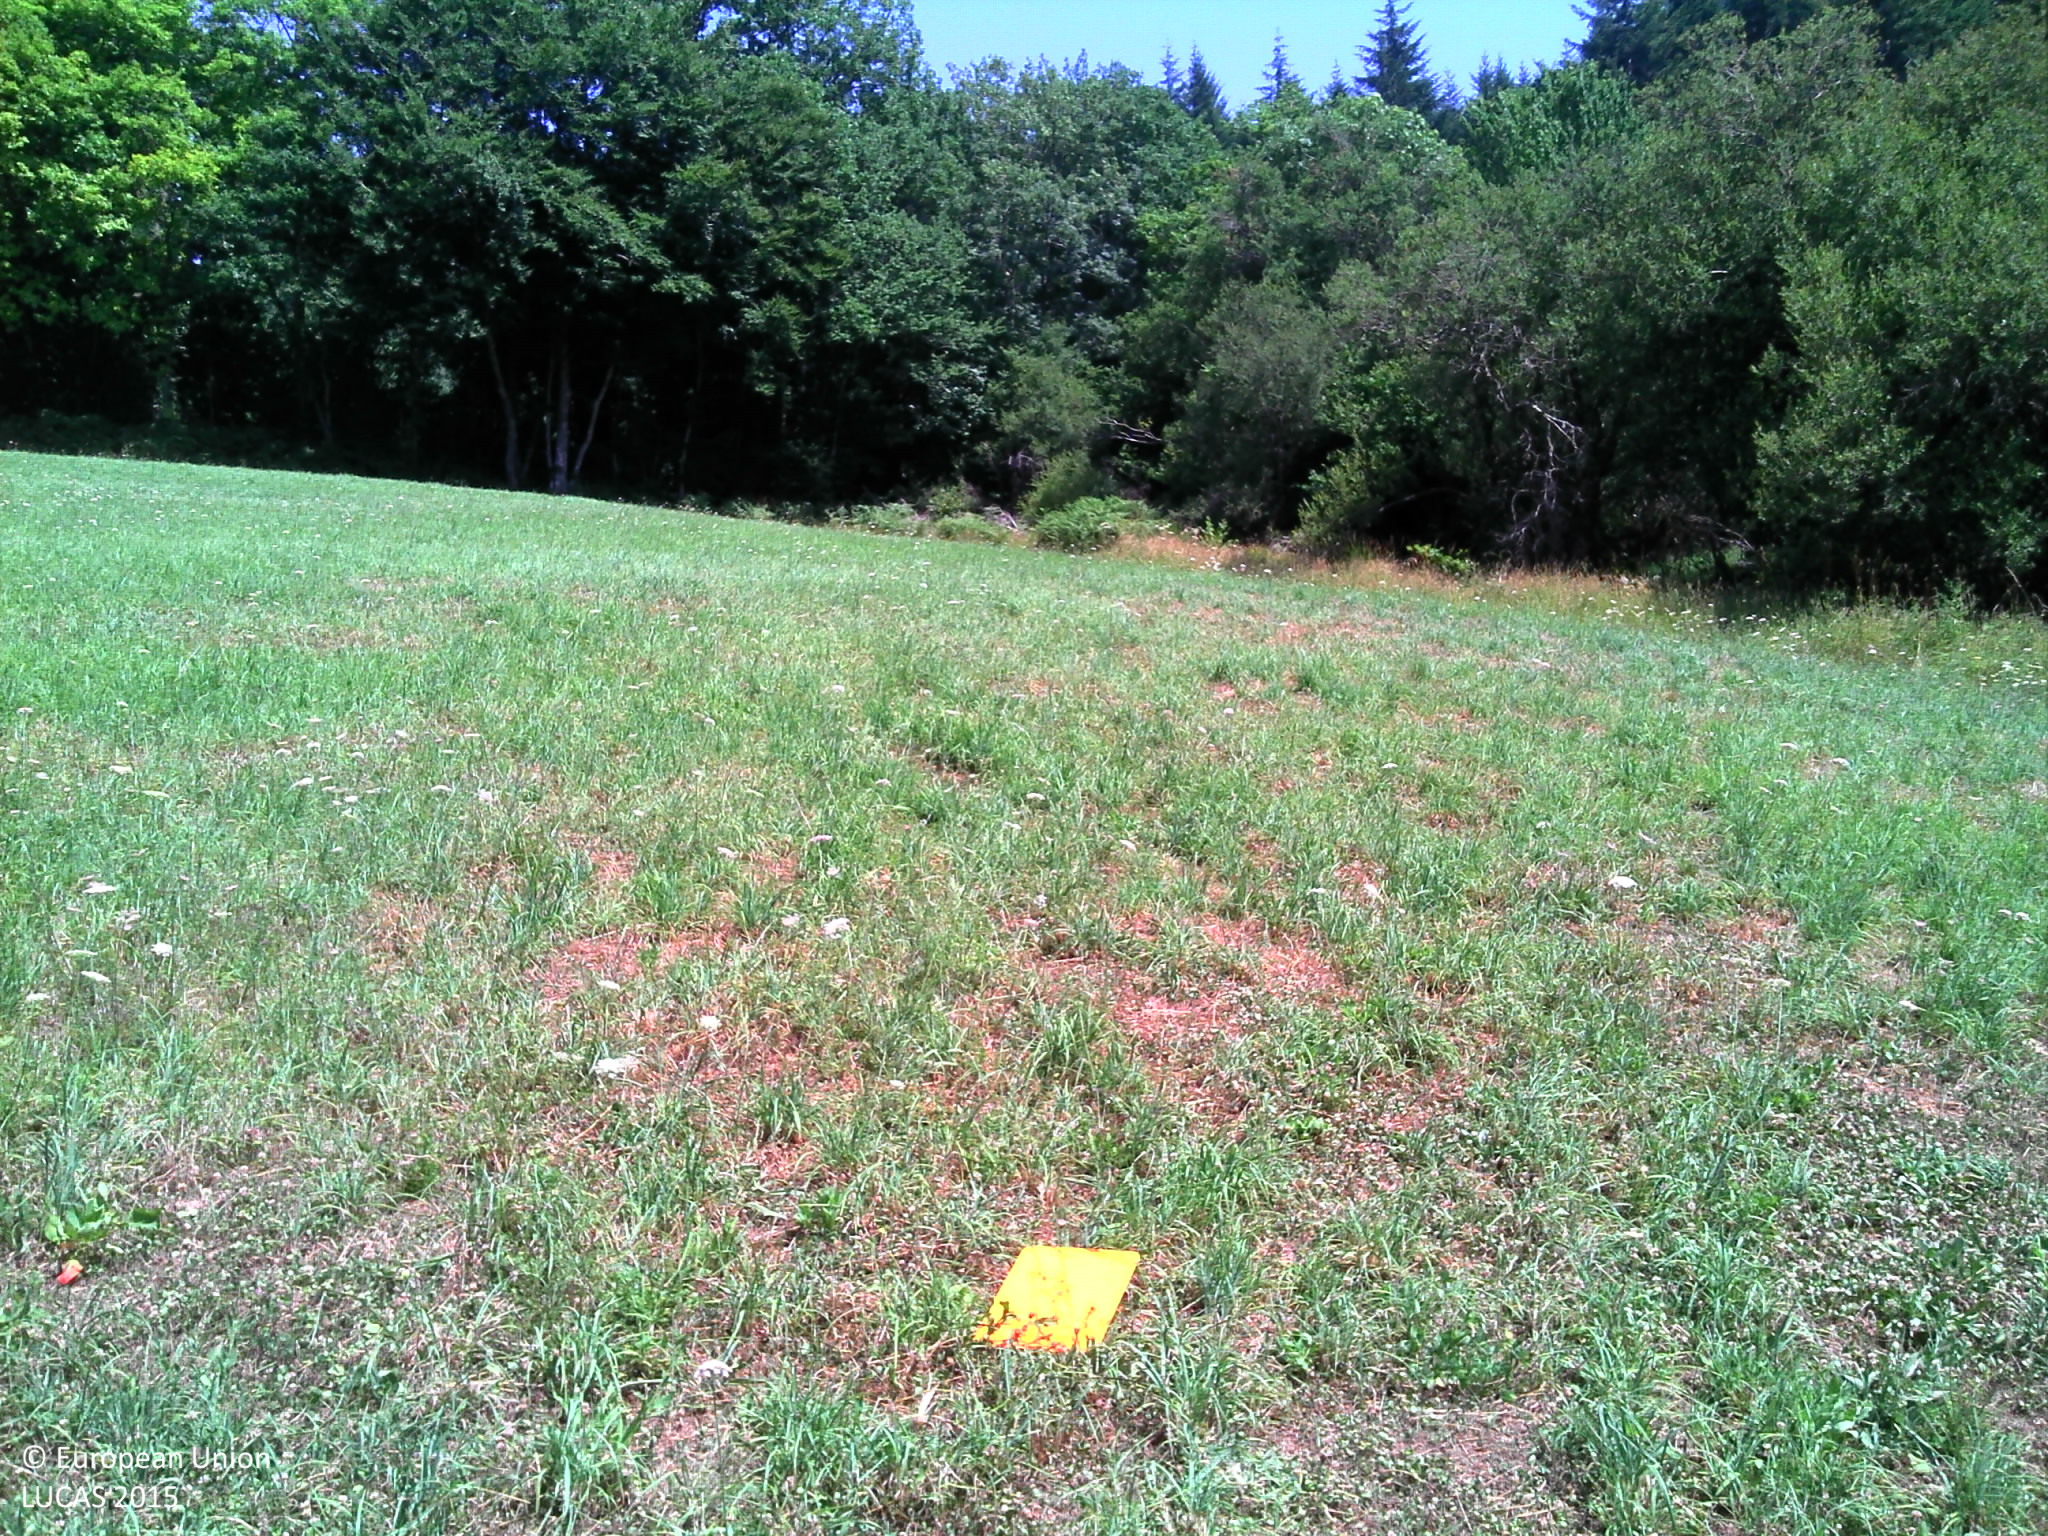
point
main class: Grassland
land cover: Grassland without tree/shrub cover
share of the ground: > 75 %
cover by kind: herbaceous plants 100 %
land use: Agriculture (excluding fallow land and kitchen gardens)
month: July
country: FR
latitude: 43.6554
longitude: 2.6539
